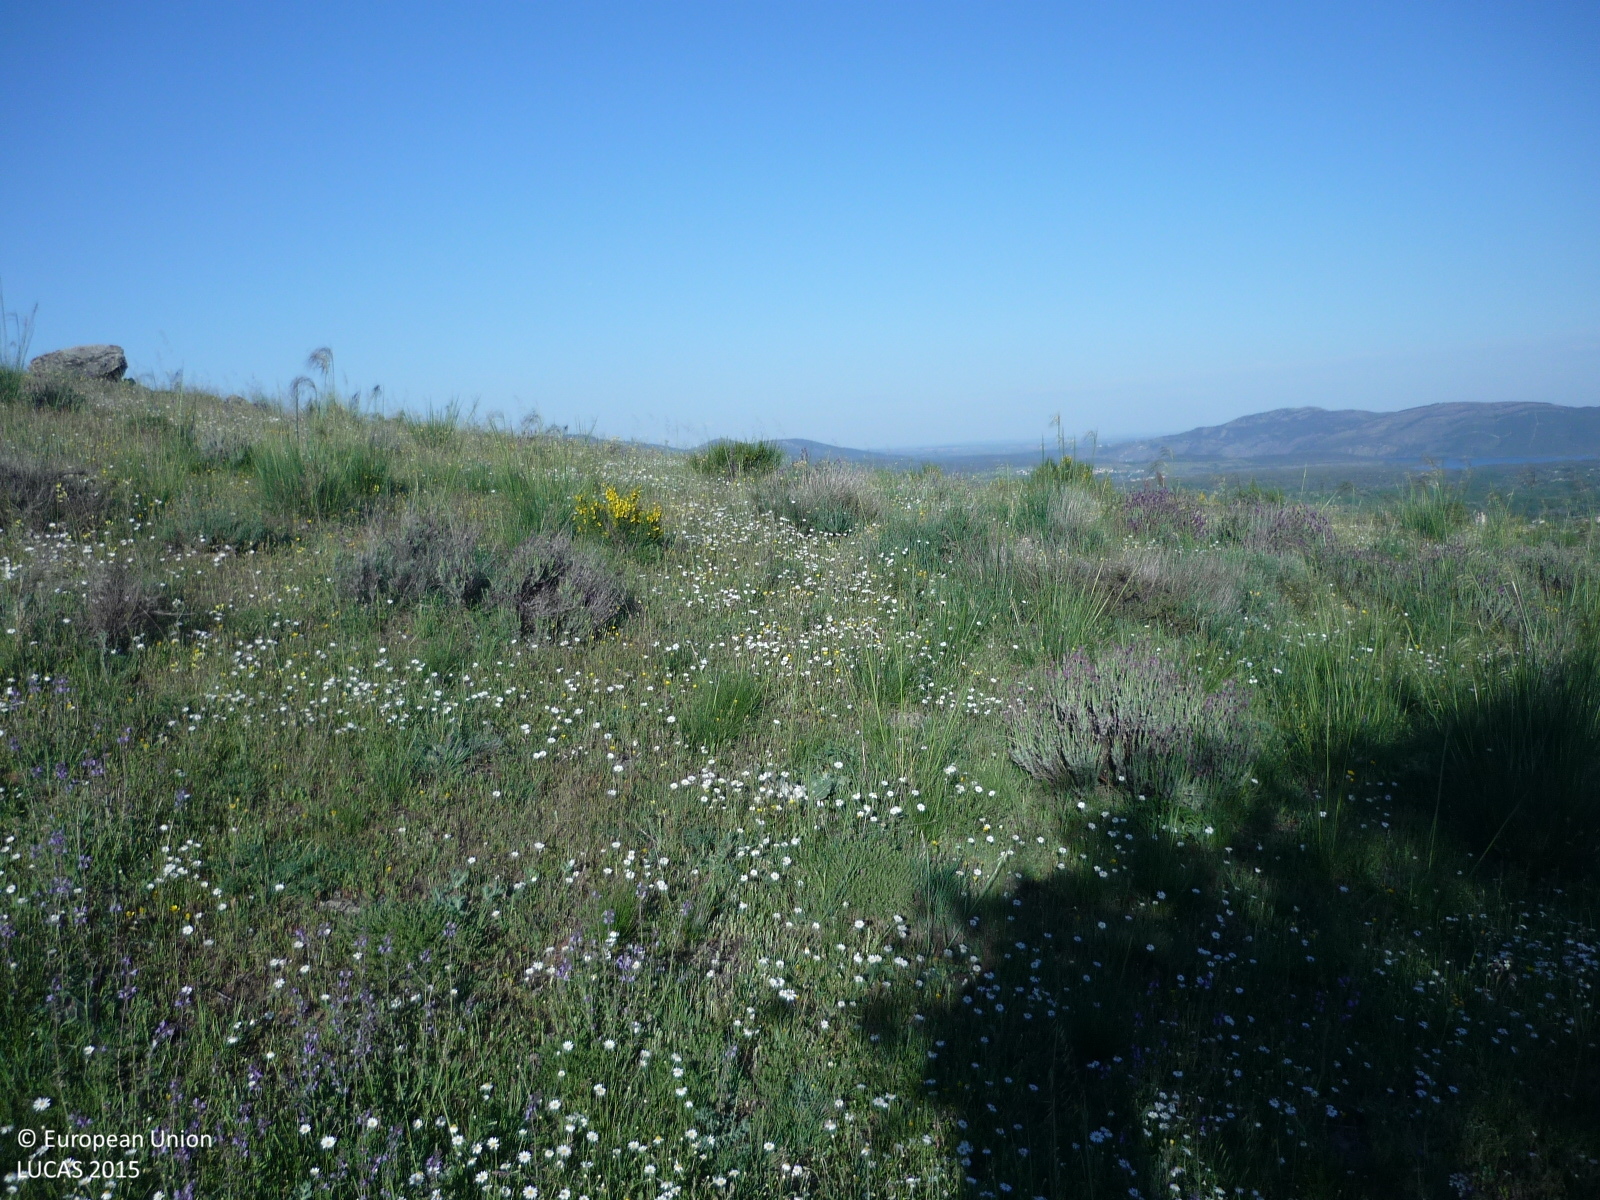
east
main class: Grassland
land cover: Grassland with sparse tree/shrub cover
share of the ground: > 75 %
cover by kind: herbaceous plants 85 %, broadleaved forest trees 5 %, shrubs 5 %, unconsolidated bare surface 5 %
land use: Agriculture (excluding fallow land and kitchen gardens)
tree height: < 5 m
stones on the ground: < 10 %
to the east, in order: Grassland with sparse tree/shrub cover; Grassland without tree/shrub cover; Dry stone walls; Shrubland without tree cover; Tracks; Shrubland without tree cover; Shrubland with sparse tree cover; Dry stone walls; Shrubland without tree cover
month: May
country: ES
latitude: 40.9392
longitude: -3.6432
